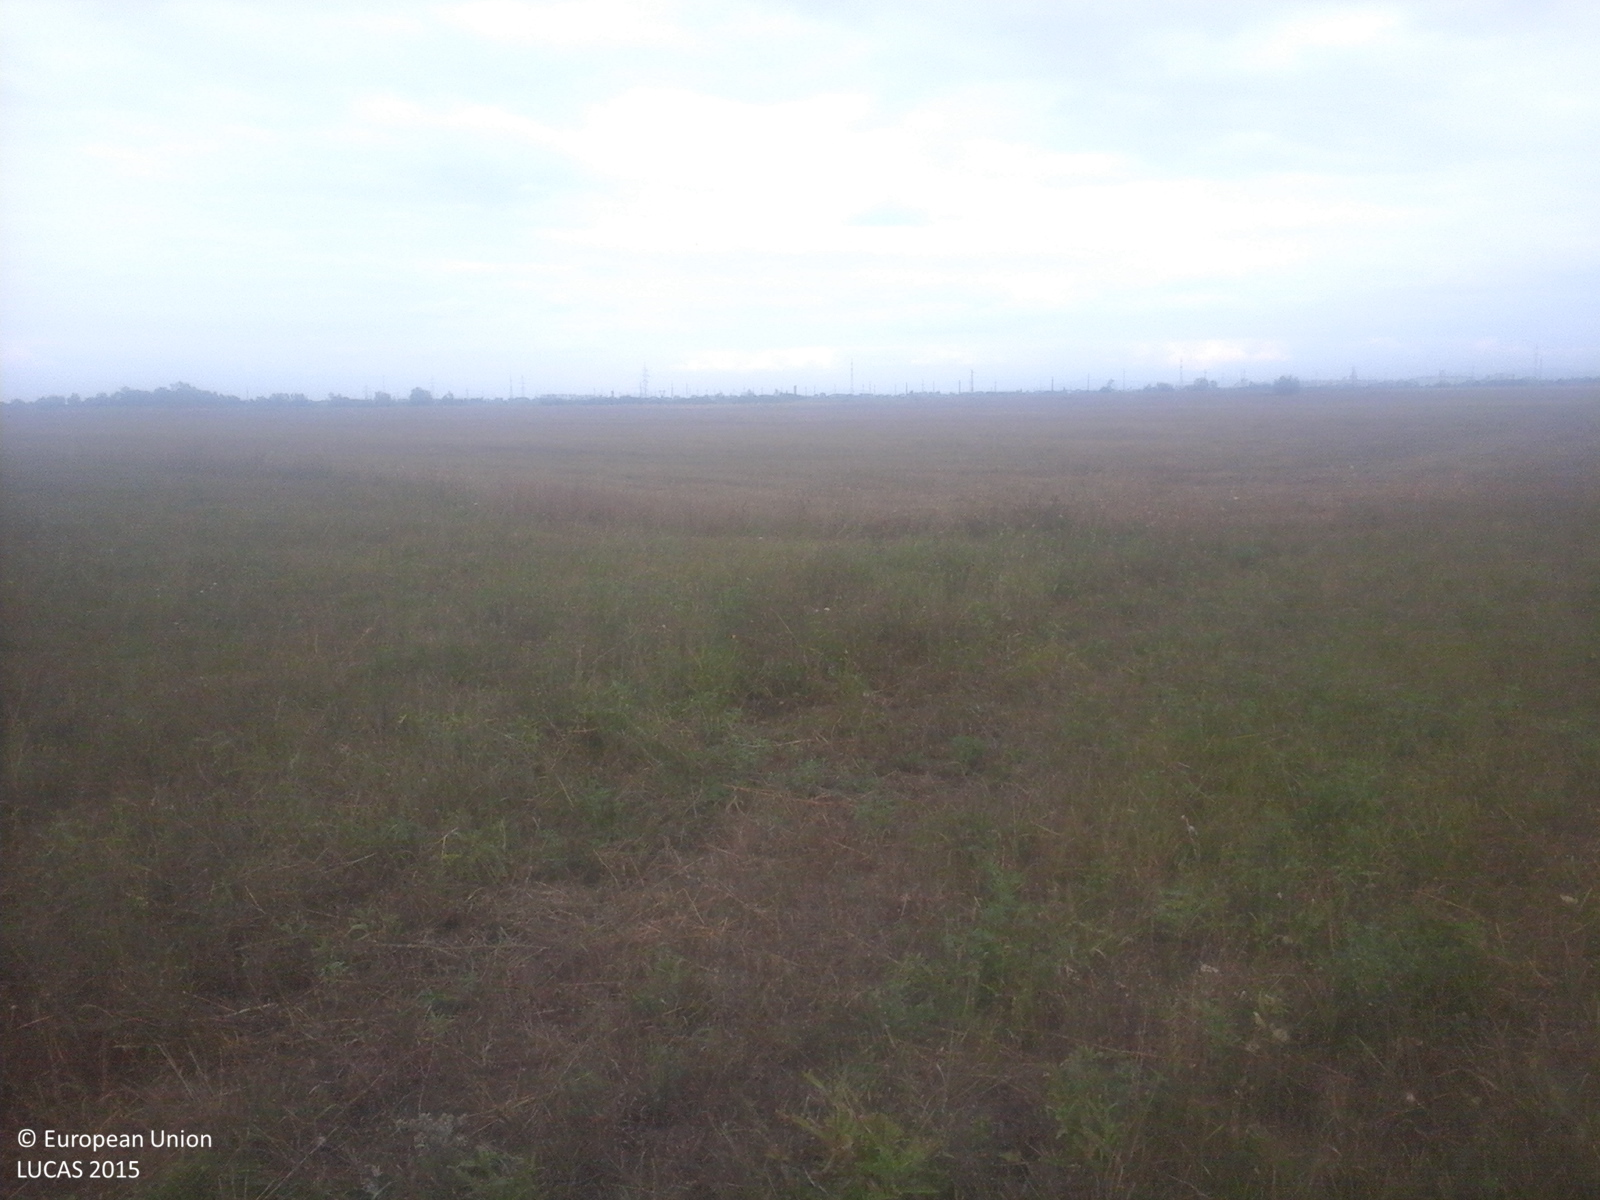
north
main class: Grassland
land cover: Grassland without tree/shrub cover
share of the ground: > 75 %
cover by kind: herbaceous plants 100 %
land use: Agriculture (excluding fallow land and kitchen gardens)
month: September
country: RO
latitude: 47.7469
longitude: 22.8006
